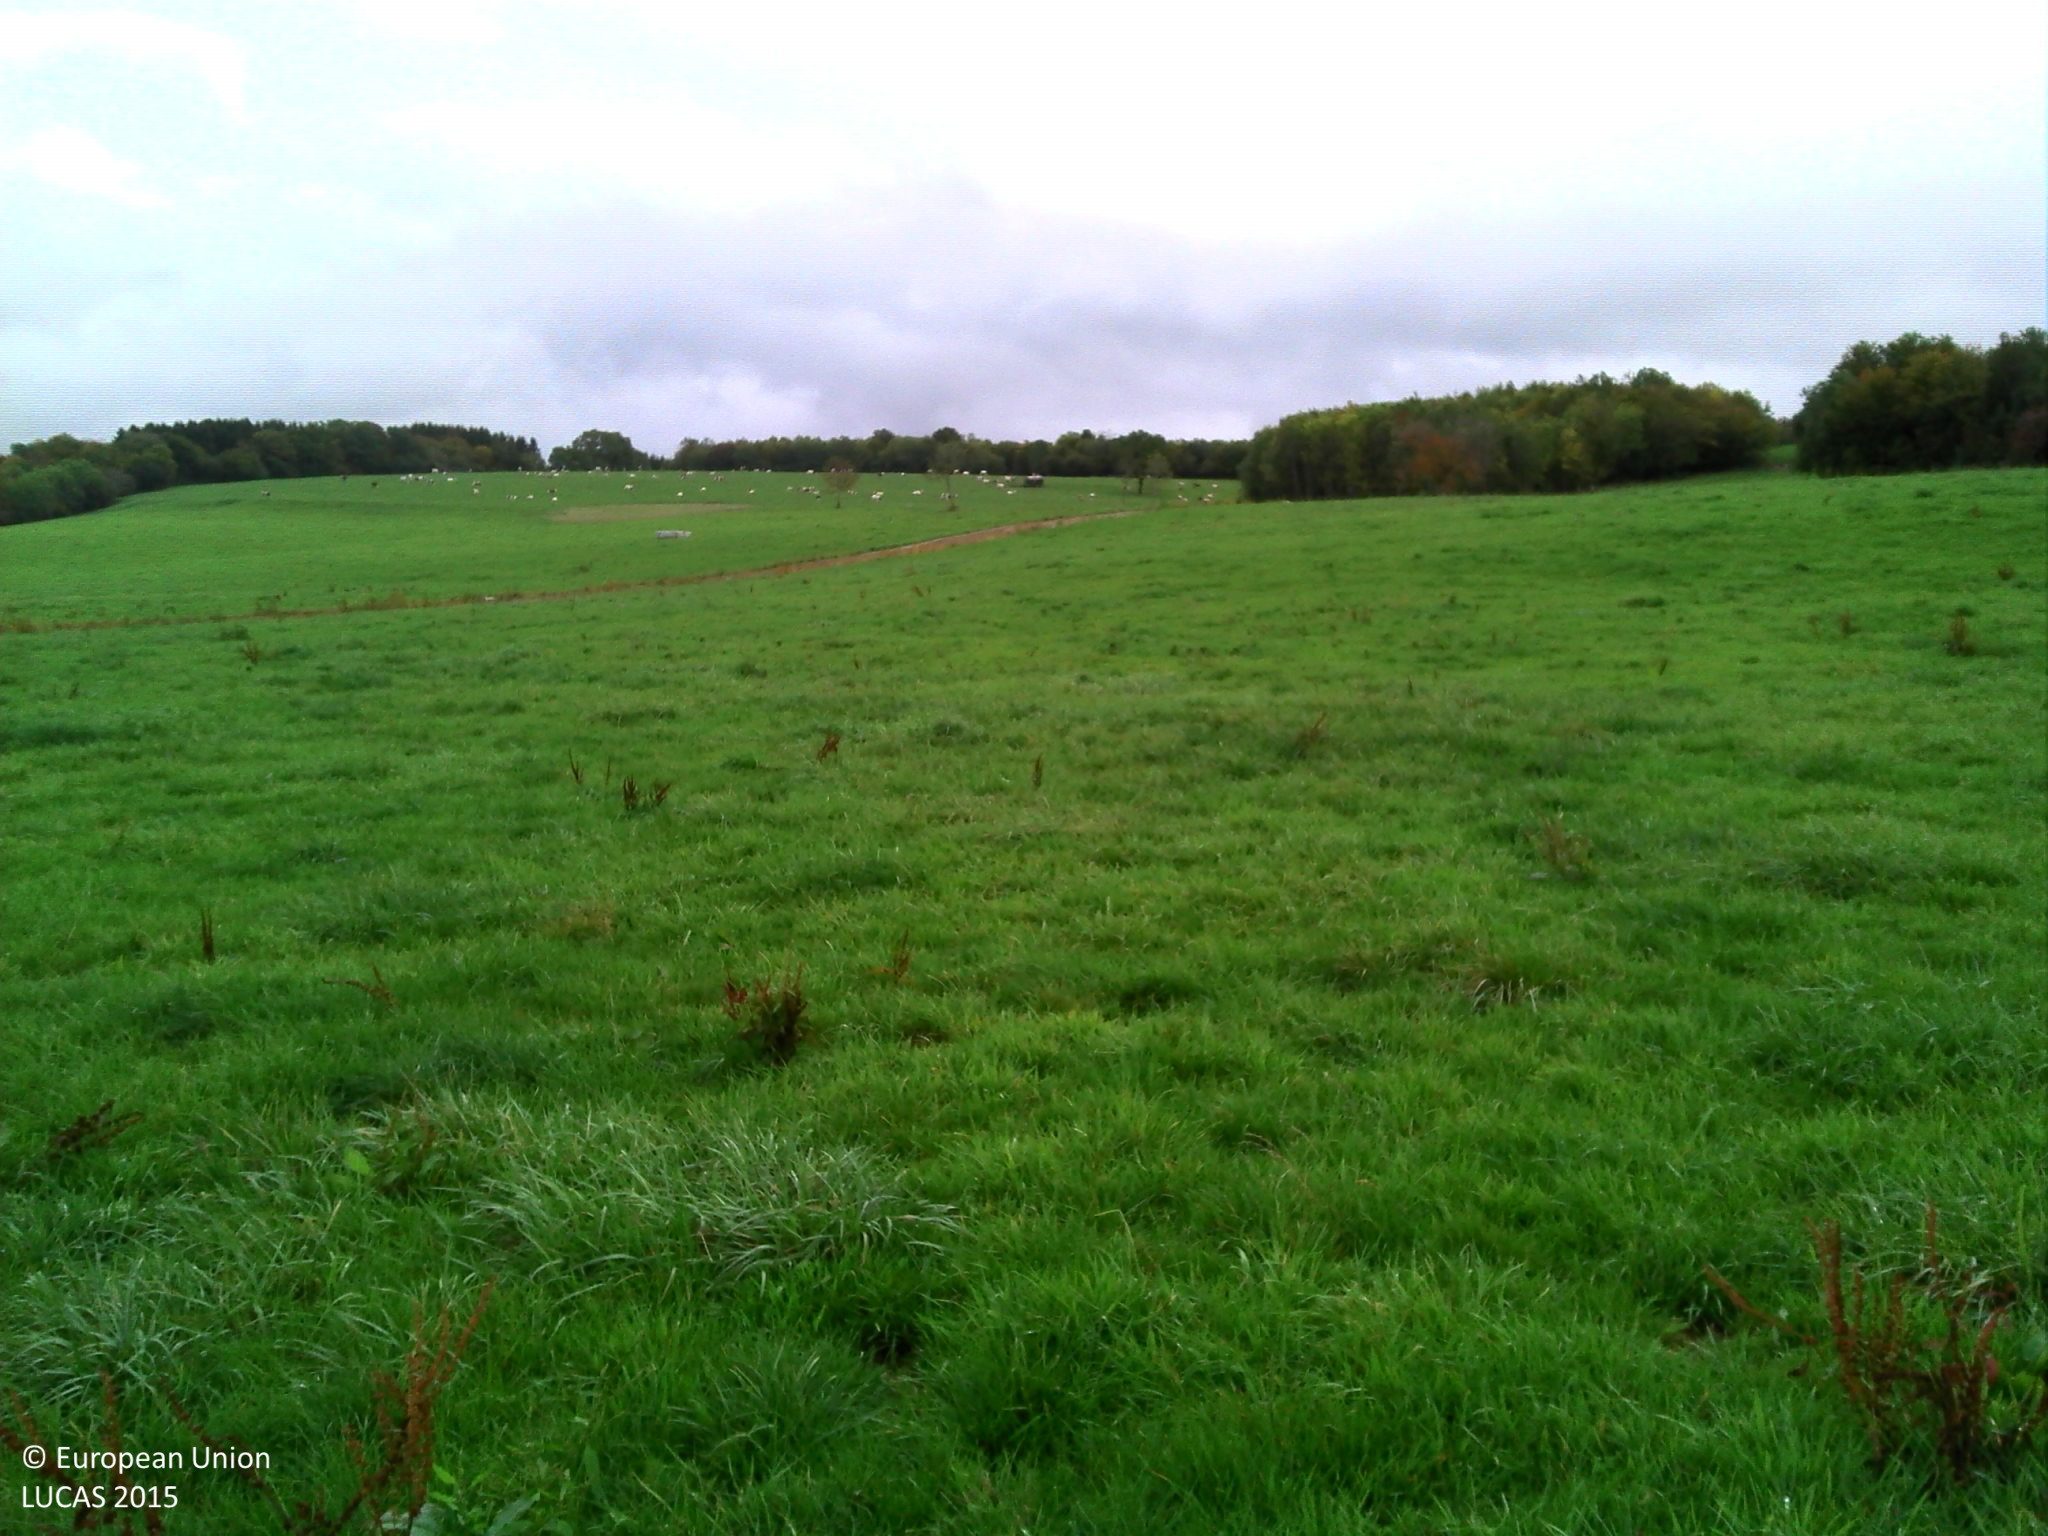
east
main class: Grassland
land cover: Grassland without tree/shrub cover
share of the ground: > 75 %
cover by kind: herbaceous plants 100 %
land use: Agriculture (excluding fallow land and kitchen gardens)
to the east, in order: Grassland without tree/shrub cover; Fences; Tracks; Fences; Grassland without tree/shrub cover; Fences; Grassland without tree/shrub cover
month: October
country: FR
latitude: 47.0201
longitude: 6.1211
